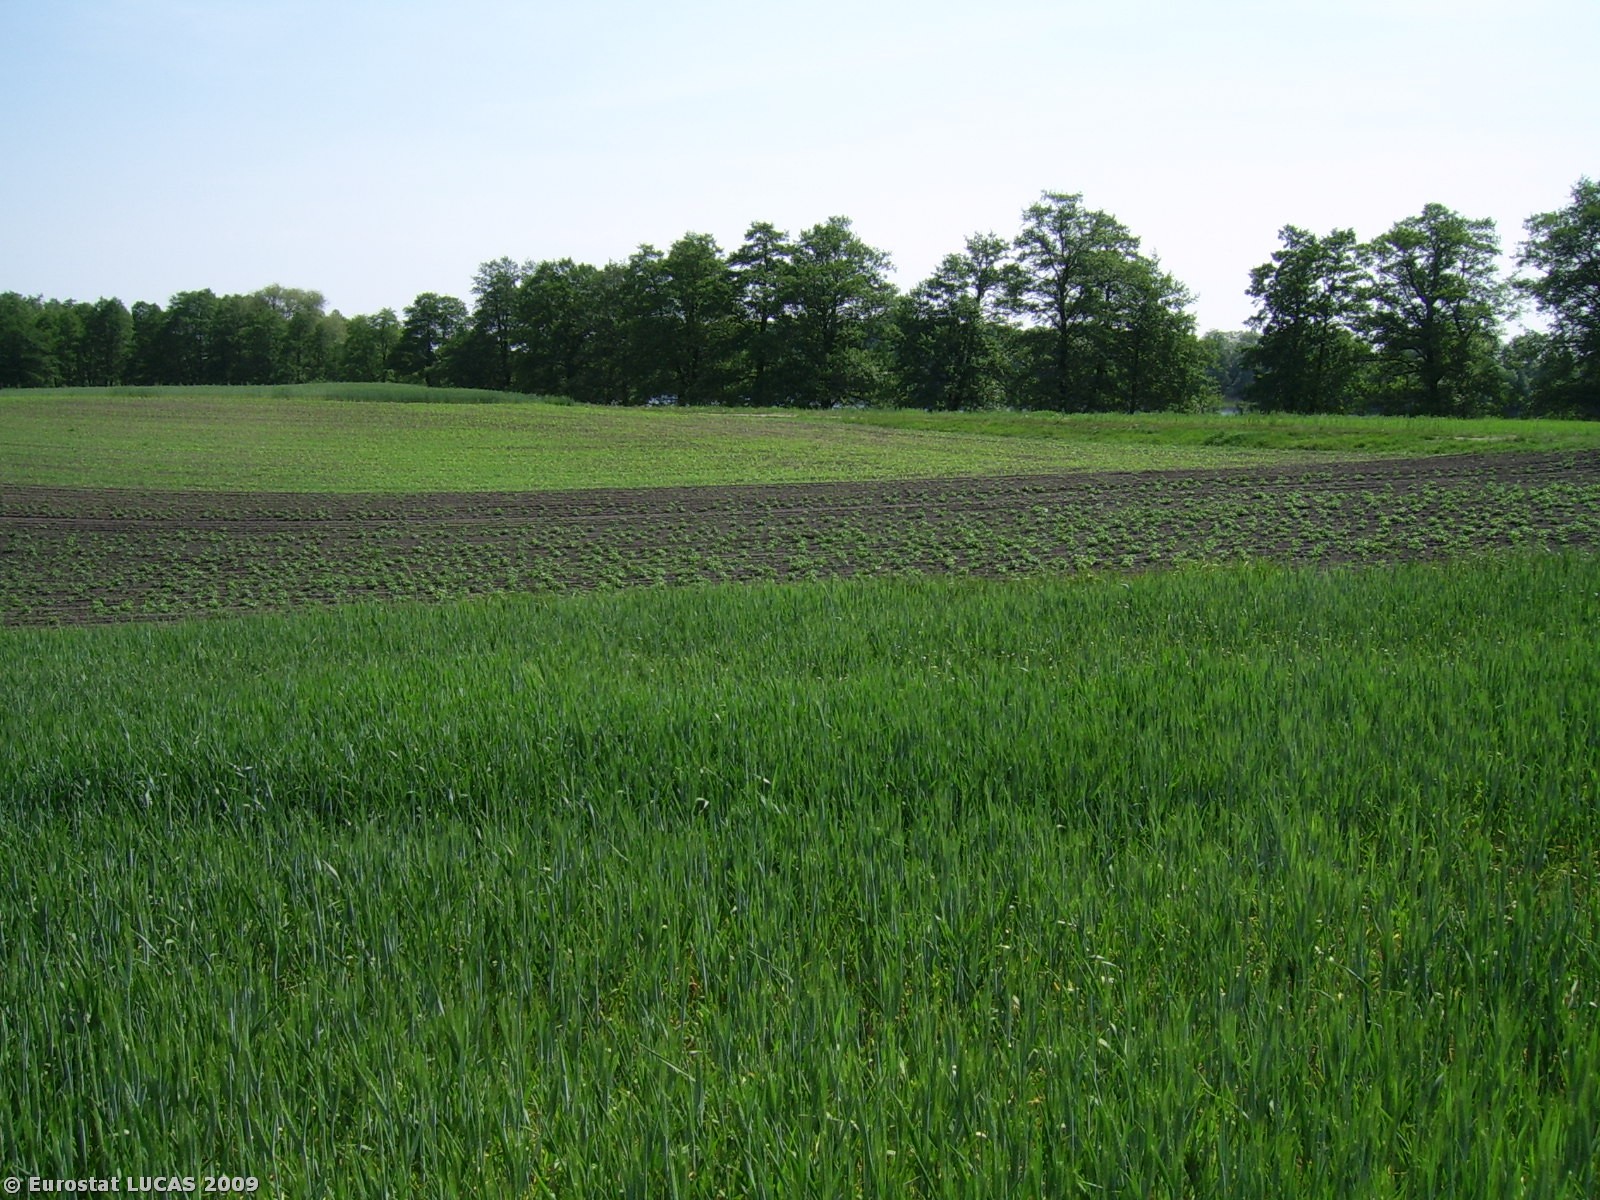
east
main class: Cropland
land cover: Rye
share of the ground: > 75 %
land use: Agriculture (excluding fallow land and kitchen gardens)
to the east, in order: Rye; Grass margins; Potatoes; Maize; Grass margins; Tracks; Grassland without tree/shrub cover; Lines of trees; Grass margins; Inland water bodies
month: May
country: PL
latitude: 52.8004
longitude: 17.6219
